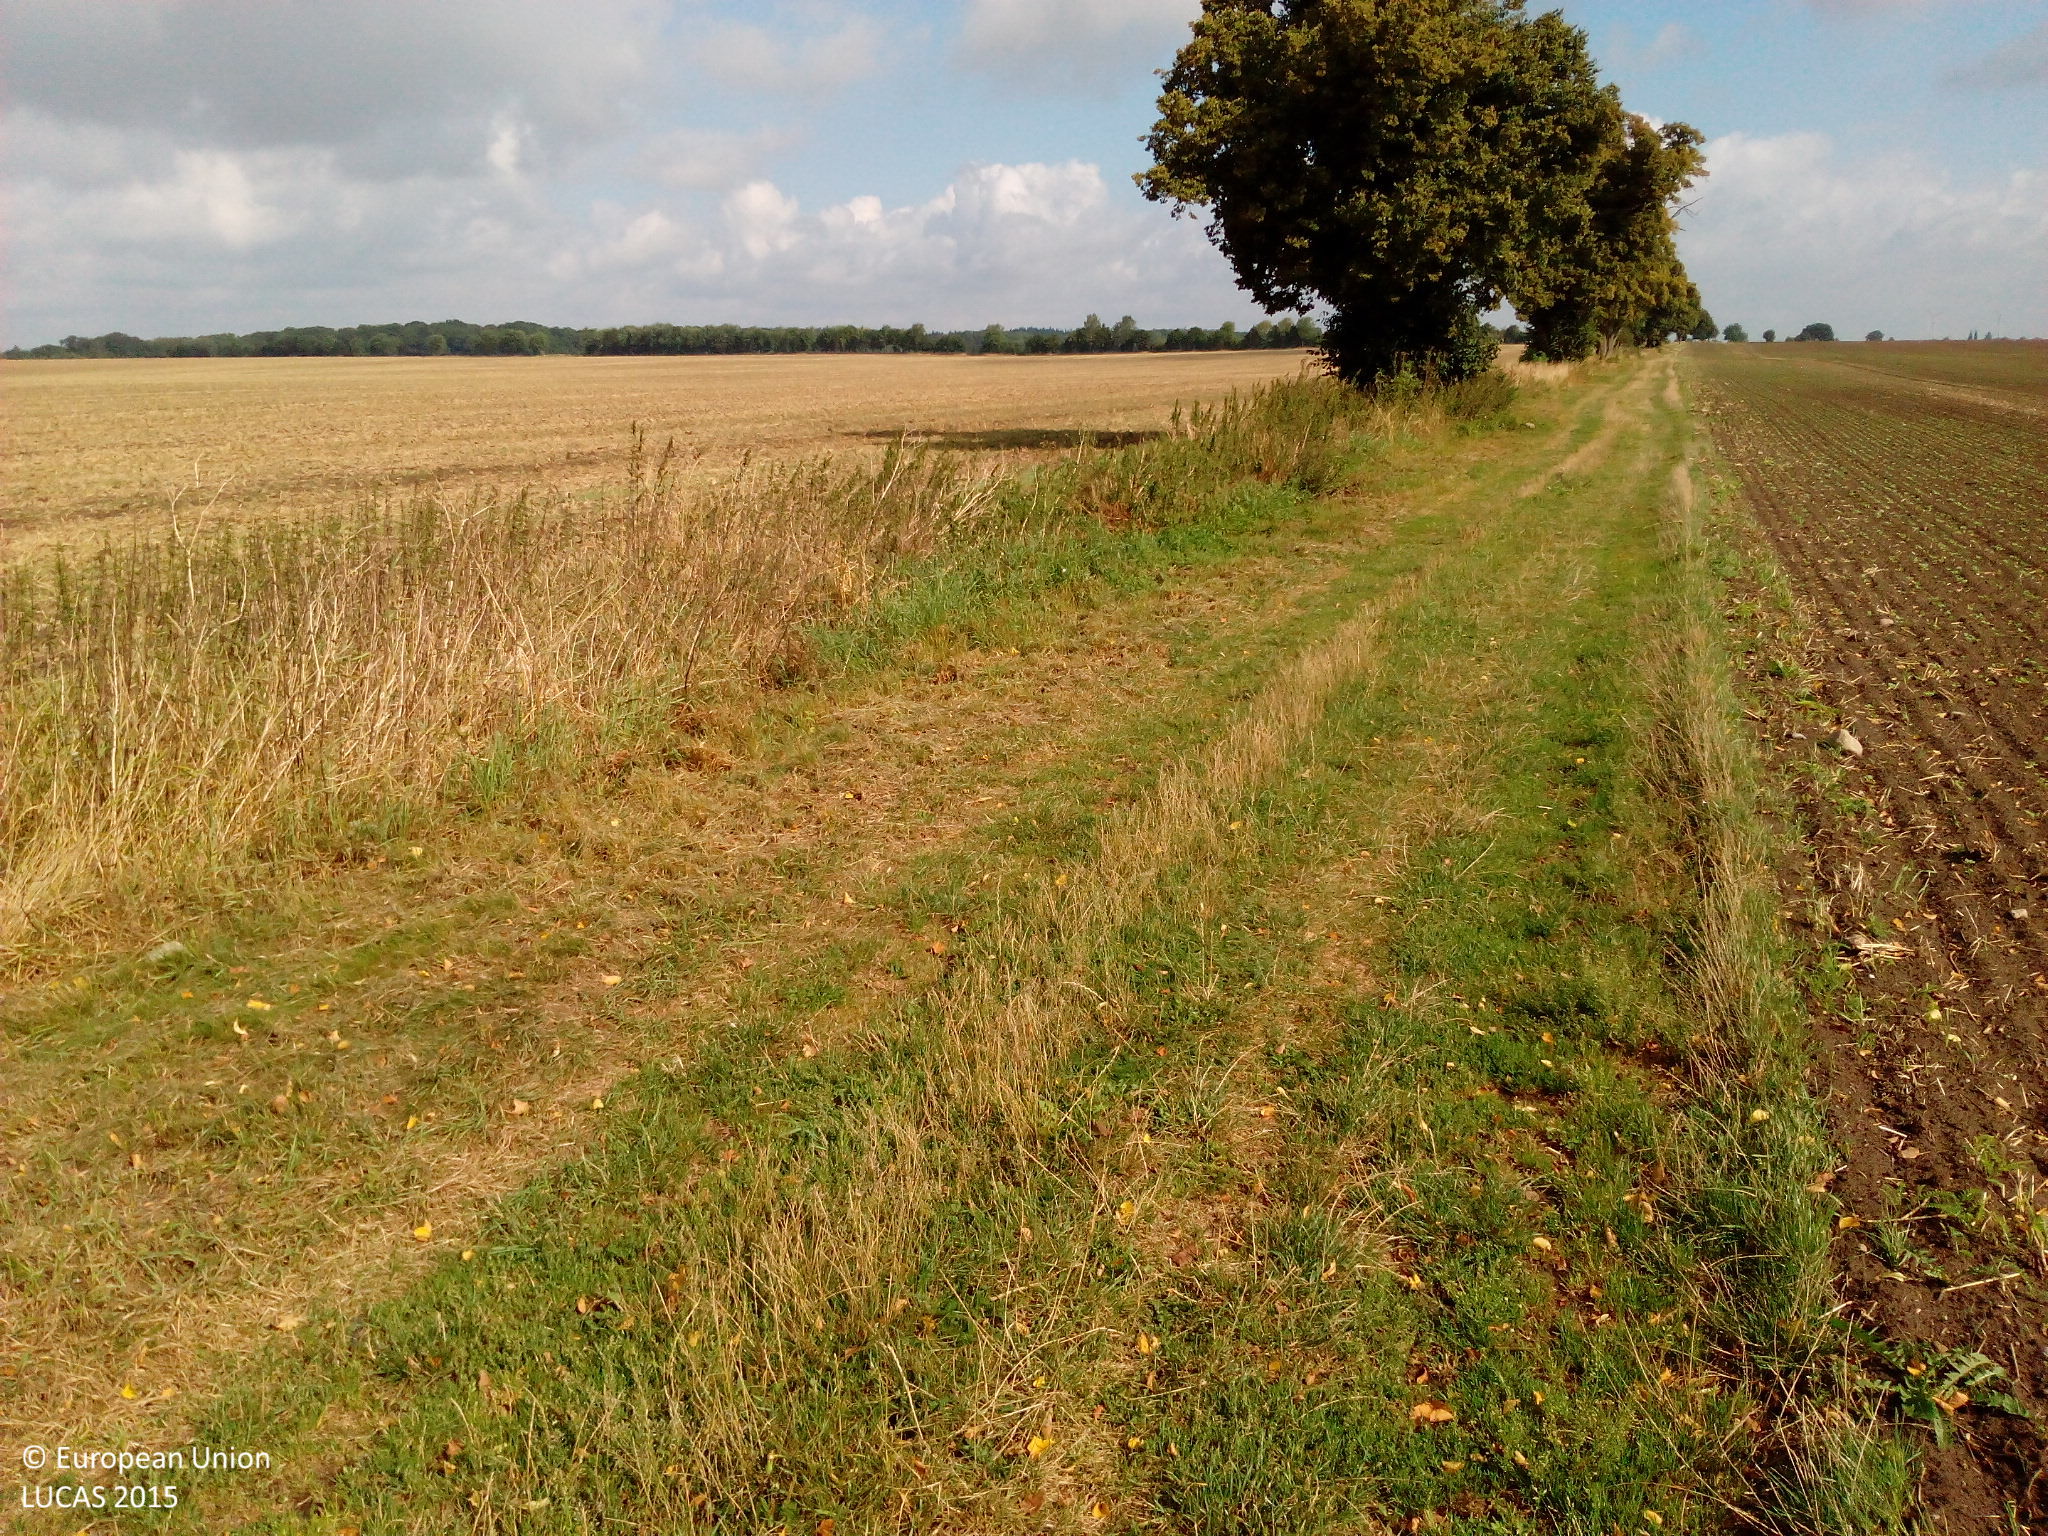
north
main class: Cropland
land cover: Rape and turnip rape
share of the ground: < 10 %
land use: Agriculture (excluding fallow land and kitchen gardens)
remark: Tilled/Sowed
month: August
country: DE
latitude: 54.0192
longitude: 12.7006
